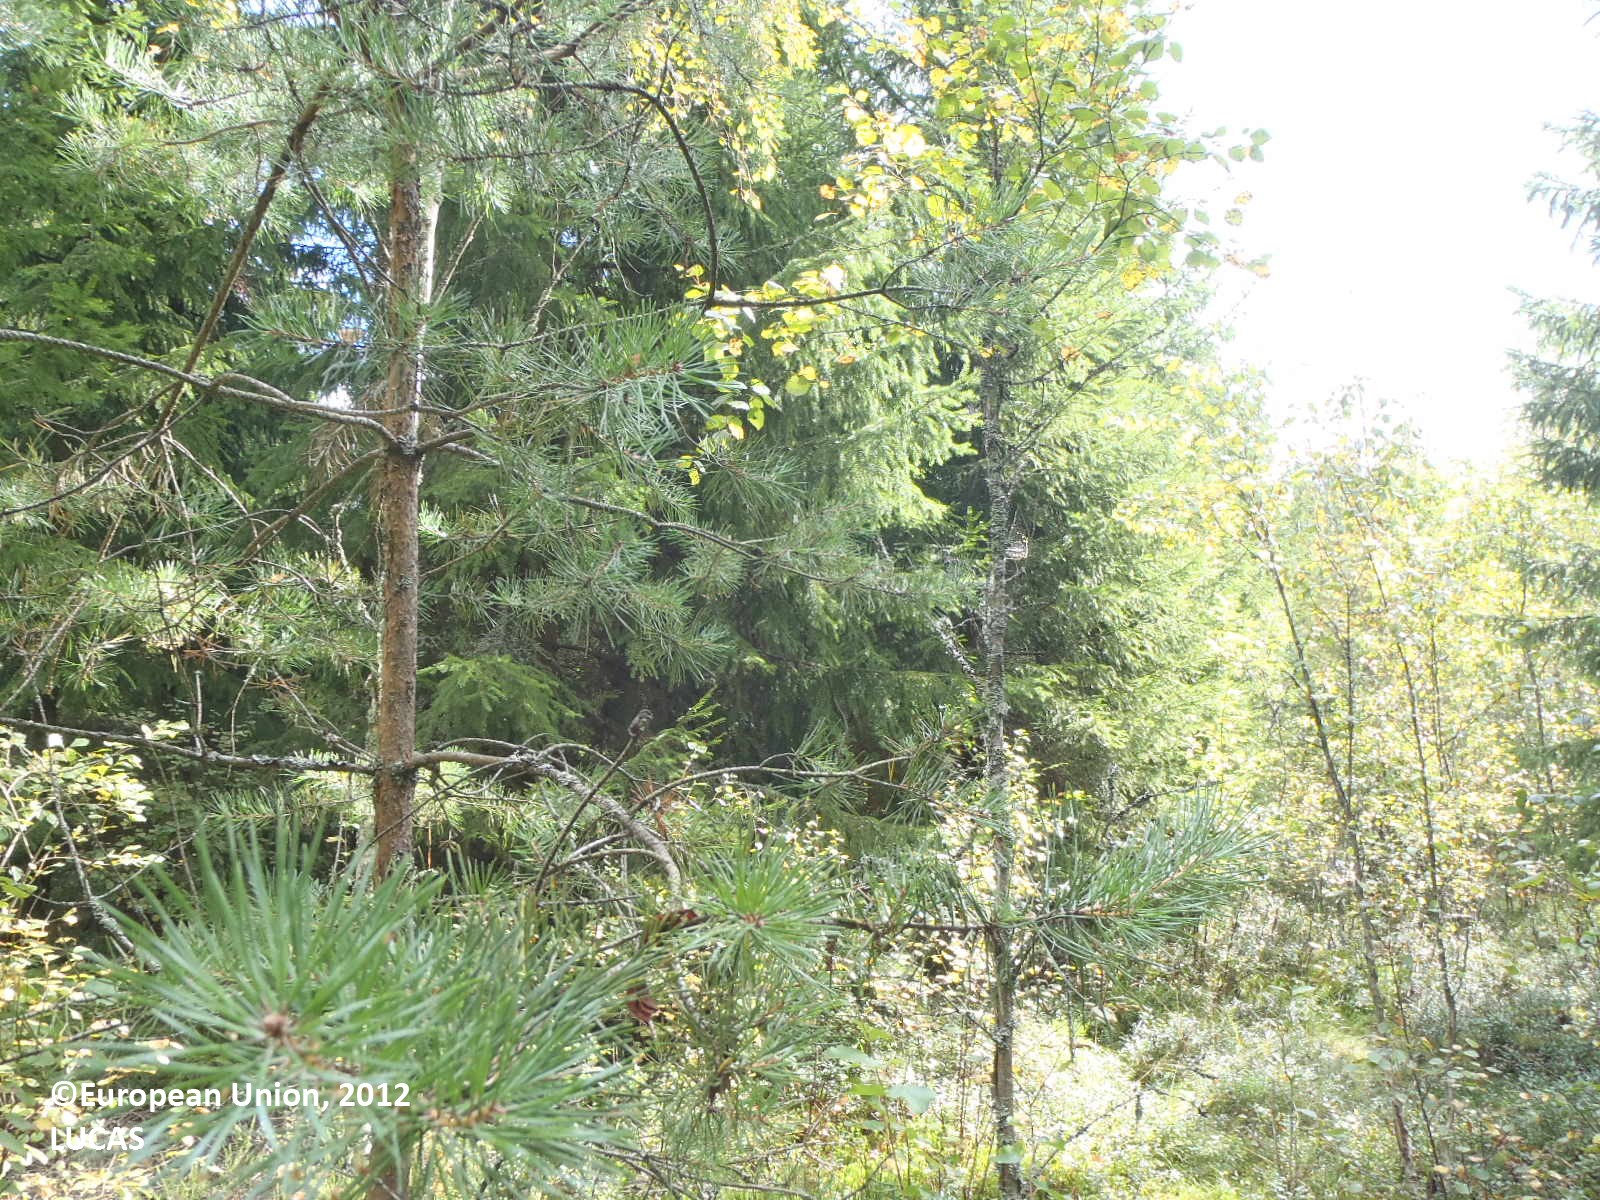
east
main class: Woodland
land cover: Spruce dominated mixed woodland
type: boreal forest
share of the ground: > 75 %
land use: Forestry
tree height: > 5 m
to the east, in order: Spruce dominated mixed woodland; Pine dominated mixed woodland; Pine dominated coniferous woodland
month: August
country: FI
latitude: 60.5316
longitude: 22.3318
